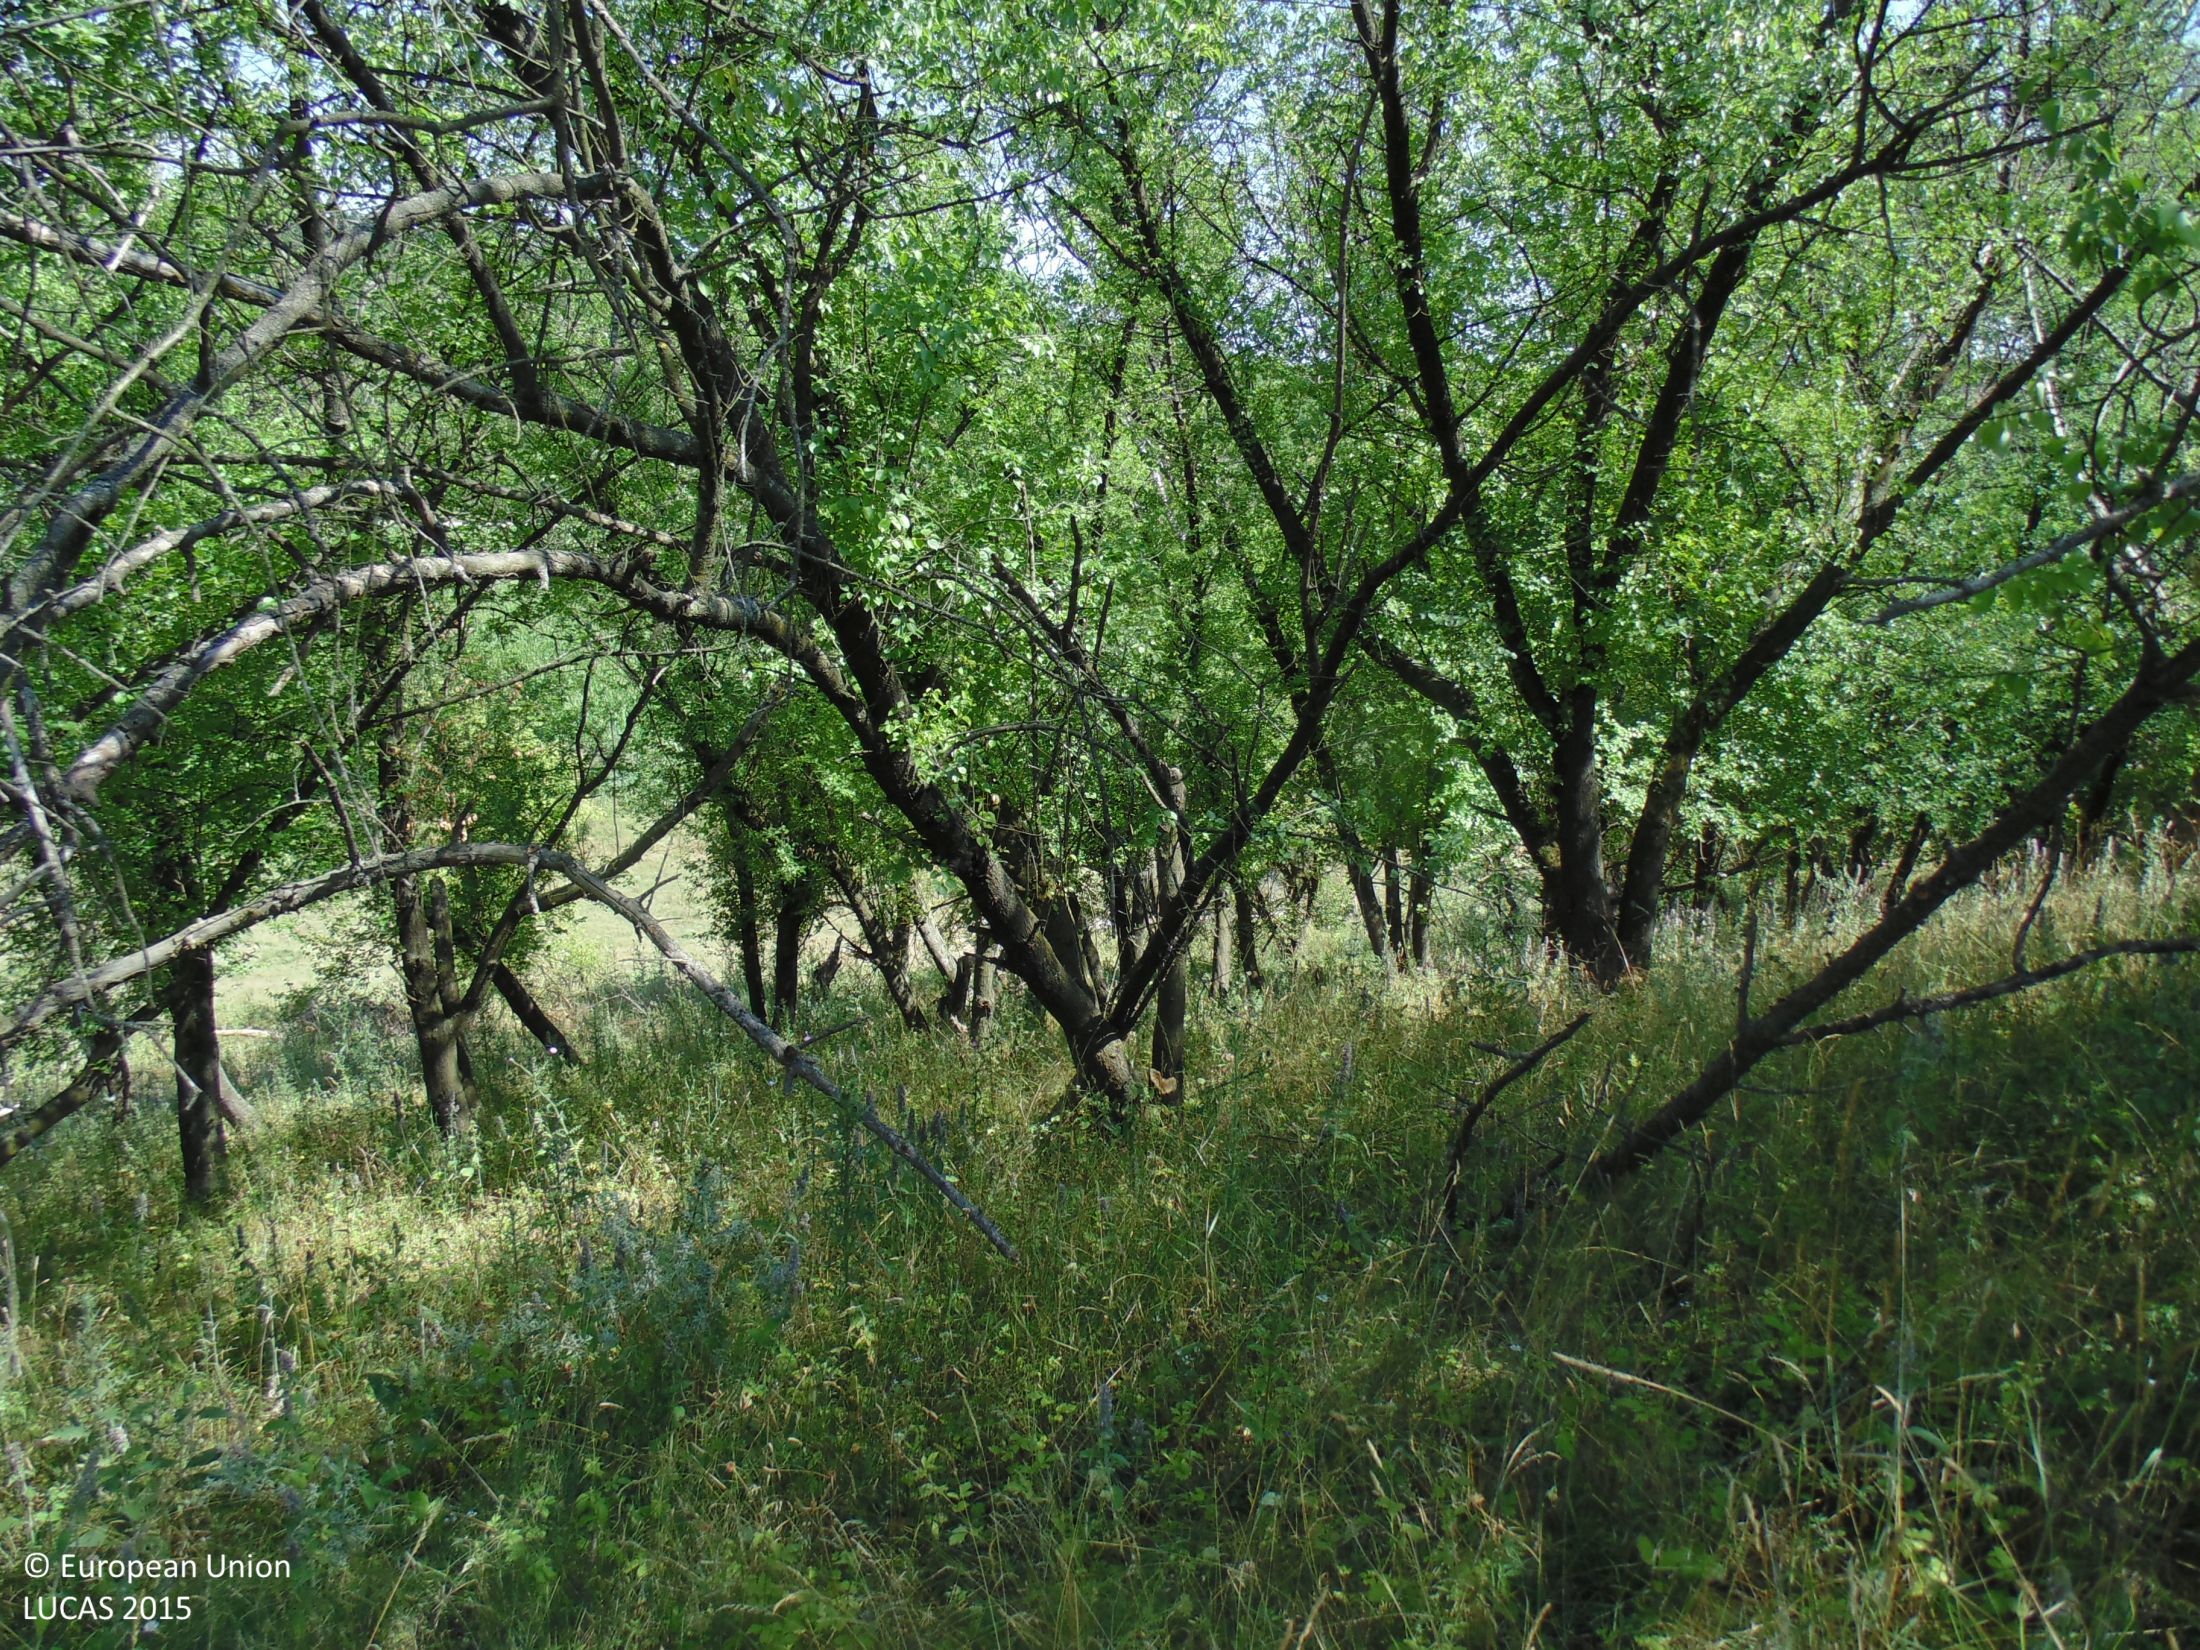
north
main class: Woodland
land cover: Broadleaved woodland
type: mesophytic deciduous forest
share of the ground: 50 - 75 %
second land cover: Grassland without tree/shrub cover
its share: > 75 %
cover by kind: broadleaved forest trees 70 %, herbaceous plants 30 %
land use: Forestry
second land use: Agriculture (excluding fallow land and kitchen gardens)
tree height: > 5 m
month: July
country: BG
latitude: 43.5166
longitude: 27.7929
